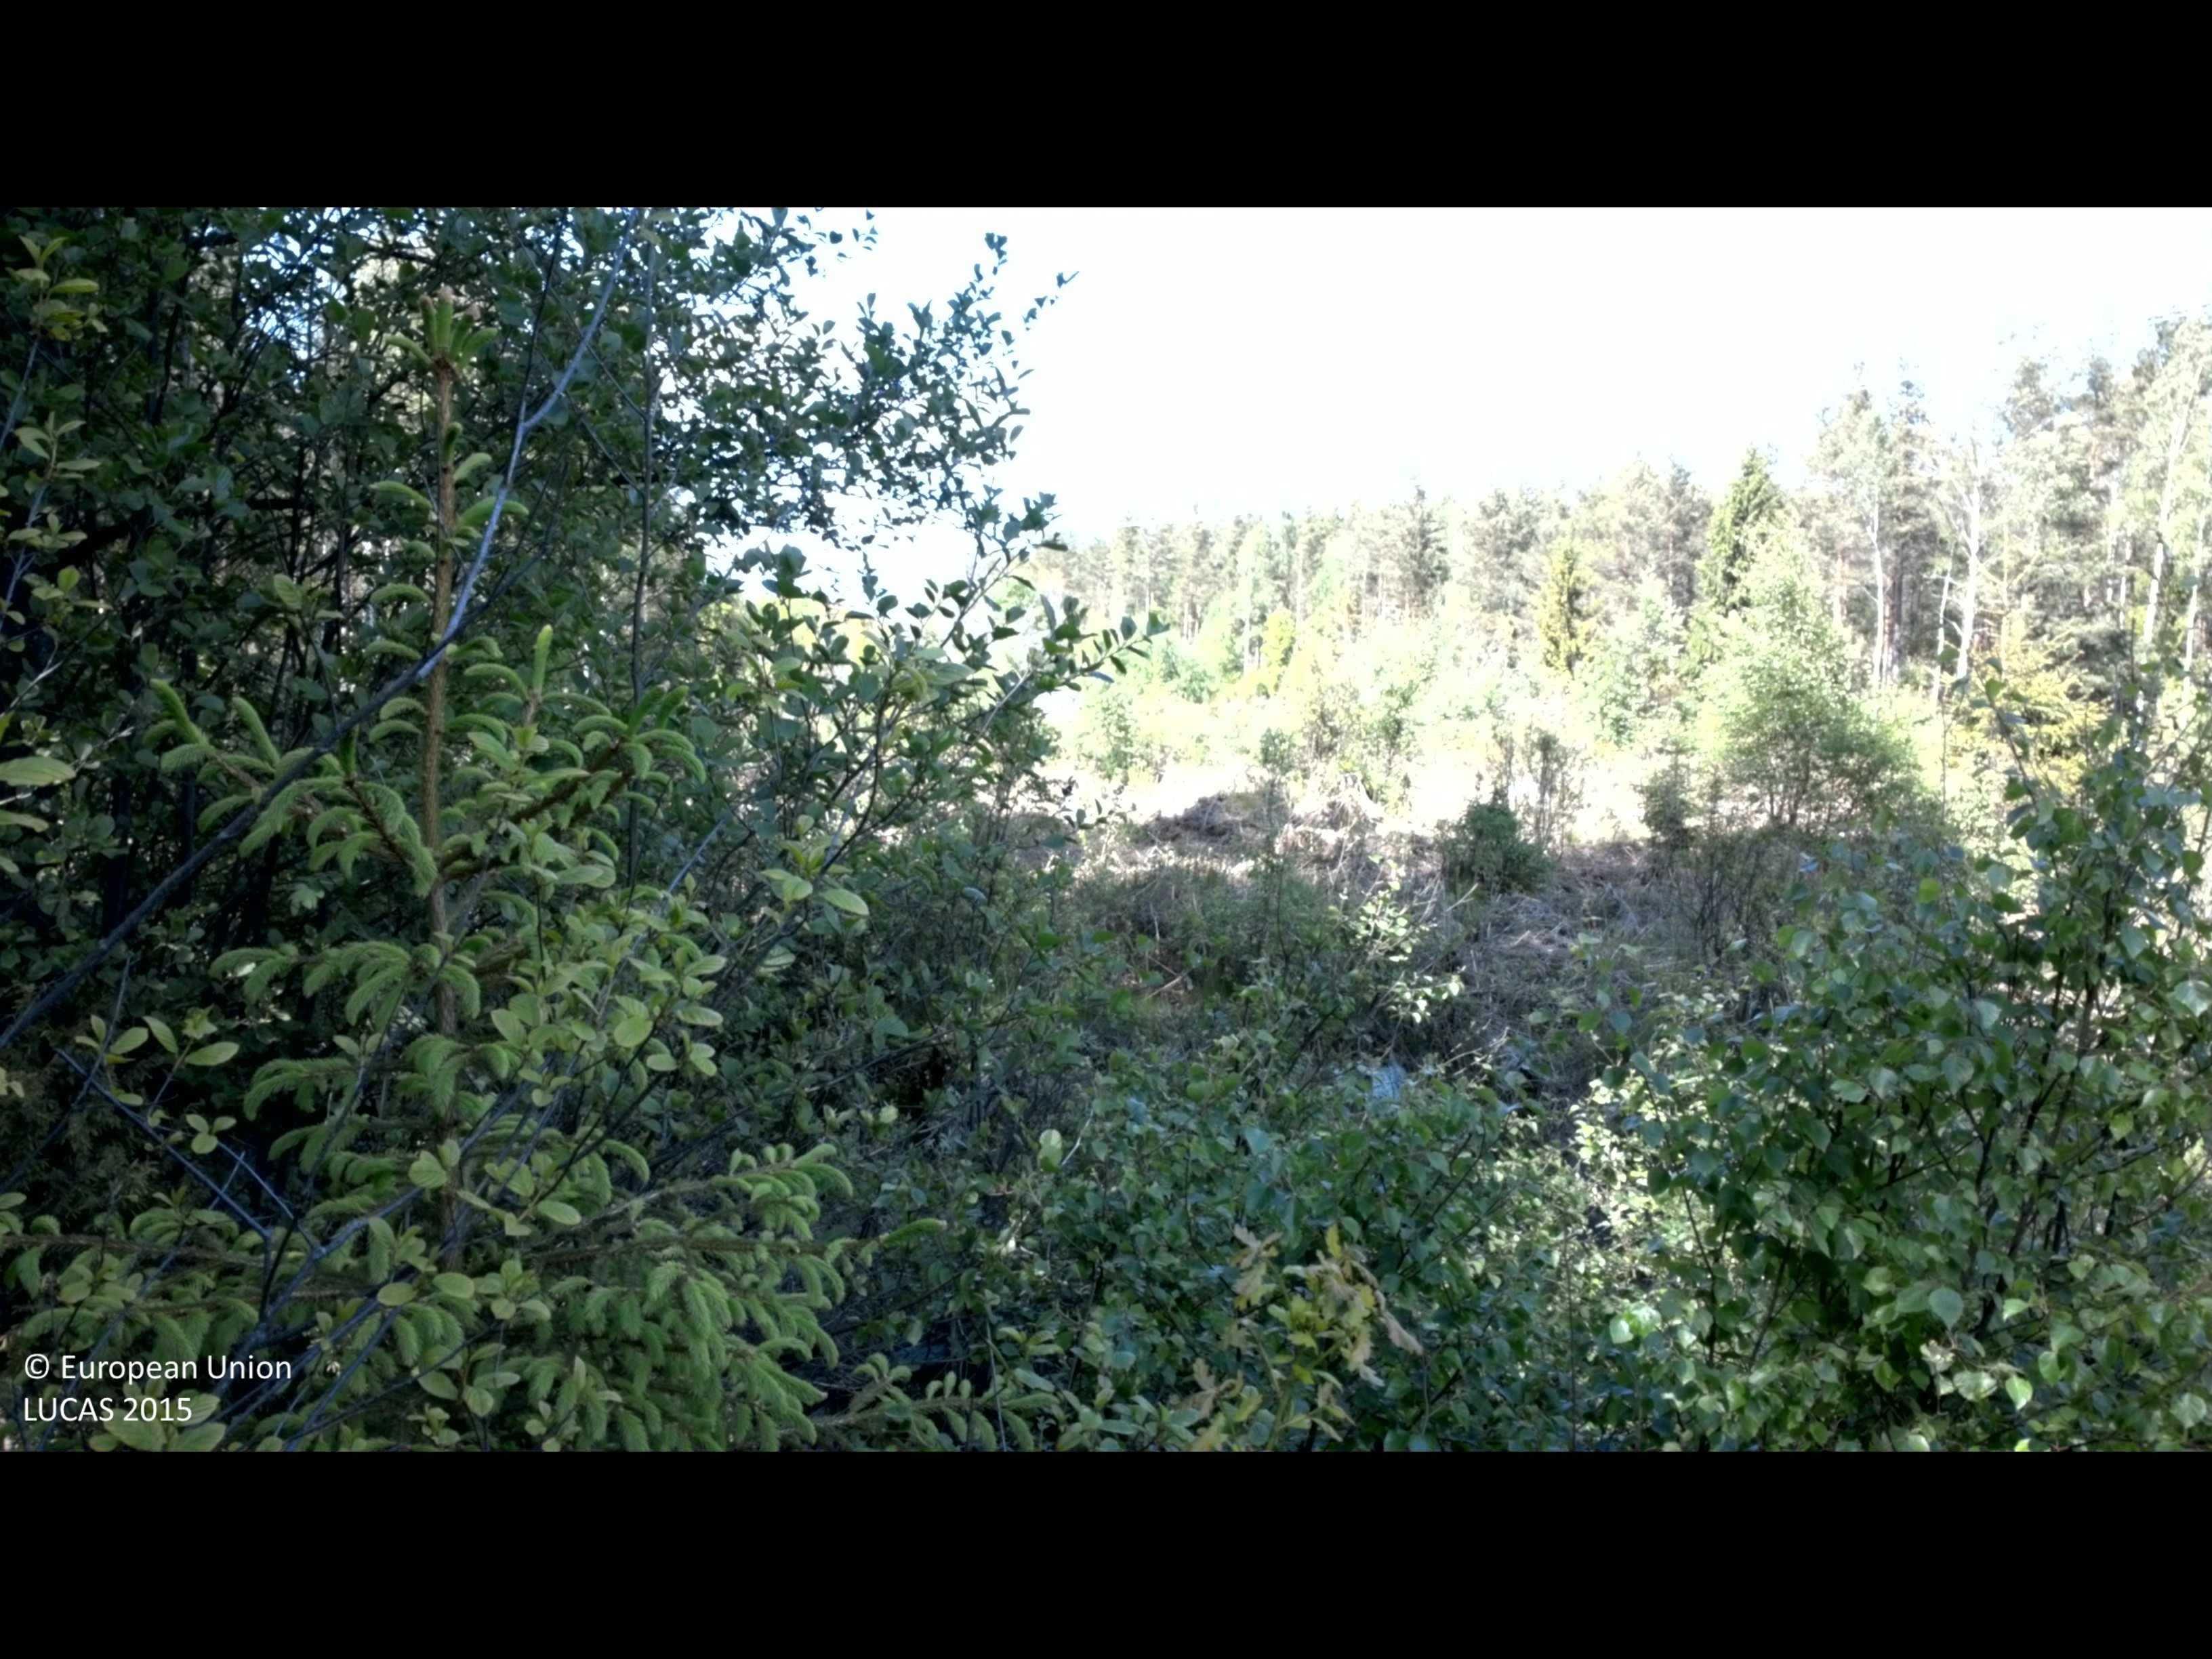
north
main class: Woodland
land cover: Broadleaved woodland
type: hemiboreal forest and nemoral coniferous forest and mixed broadleaved-coniferous forest
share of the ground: 25 - 50 %
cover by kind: shrubs 60 %, broadleaved forest trees 25 %, herbaceous plants 10 %
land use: Forestry
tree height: < 5 m
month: June
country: SE
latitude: 57.8055
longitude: 16.2070
